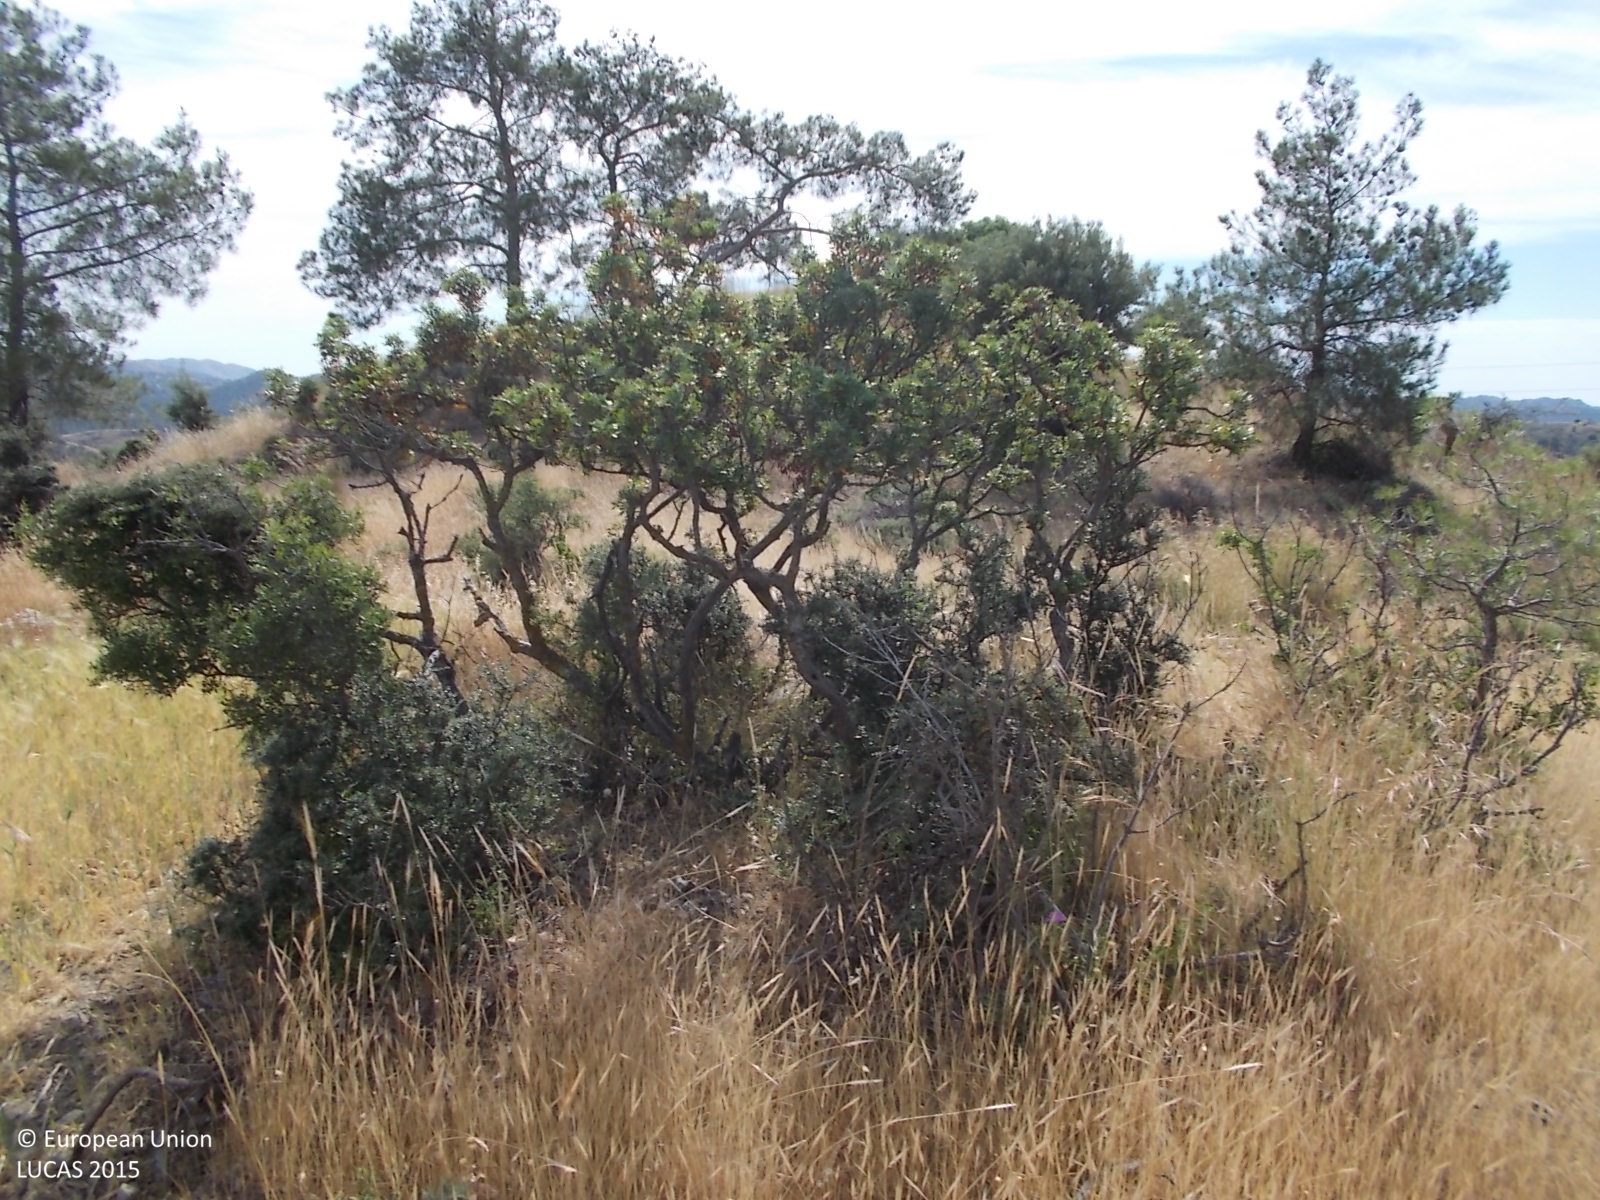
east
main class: Cropland
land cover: Barley
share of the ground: > 75 %
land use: Agriculture (excluding fallow land and kitchen gardens)
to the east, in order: Barley; Pine dominated coniferous woodland; Shrubland without tree cover; Shrubland with sparse tree cover; Barley; Shrubland without tree cover; Barley; Shrubland without tree cover; Barley; Pine dominated coniferous woodland
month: May
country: CY
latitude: 34.9144
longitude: 33.3337
